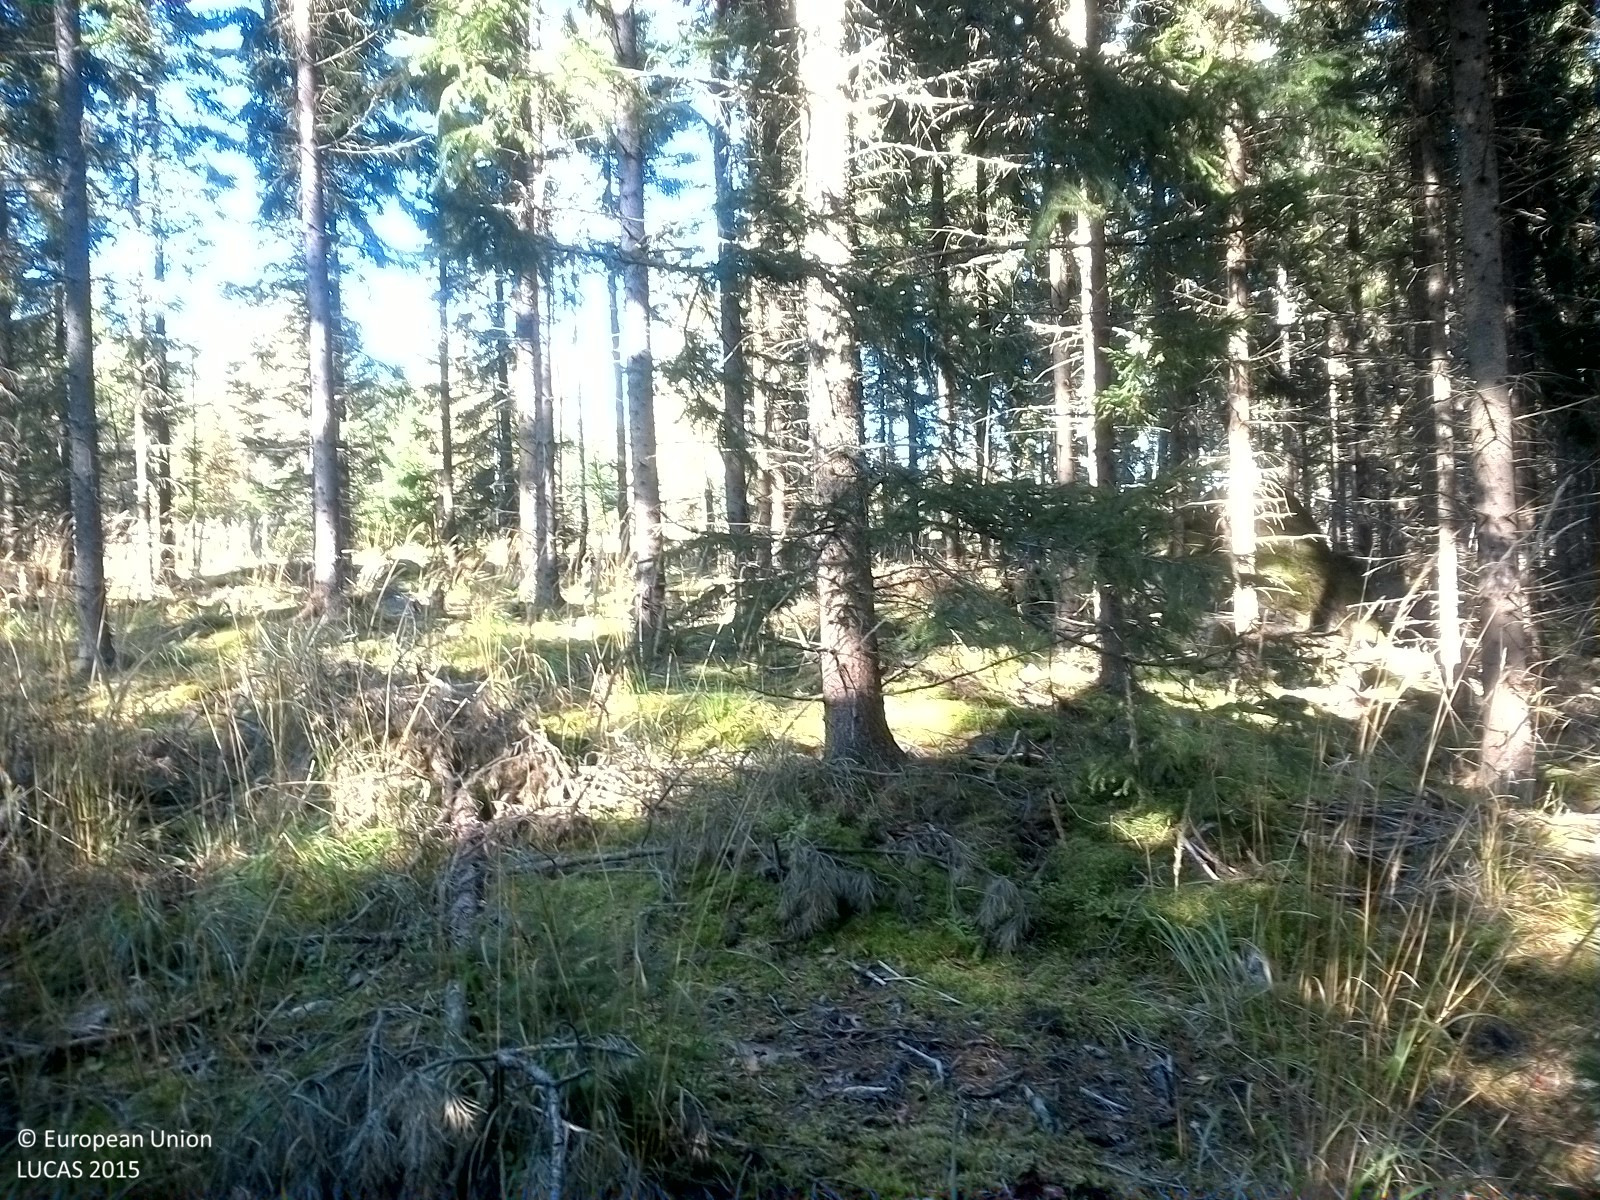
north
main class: Woodland
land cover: Pine dominated coniferous woodland
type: boreal forest
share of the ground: 25 - 50 %
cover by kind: coniferous forest trees 40 %, herbaceous plants 30 %, lichens and mosses 30 %
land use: Forestry
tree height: > 5 m
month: September
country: SE
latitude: 58.7690
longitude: 16.4448
